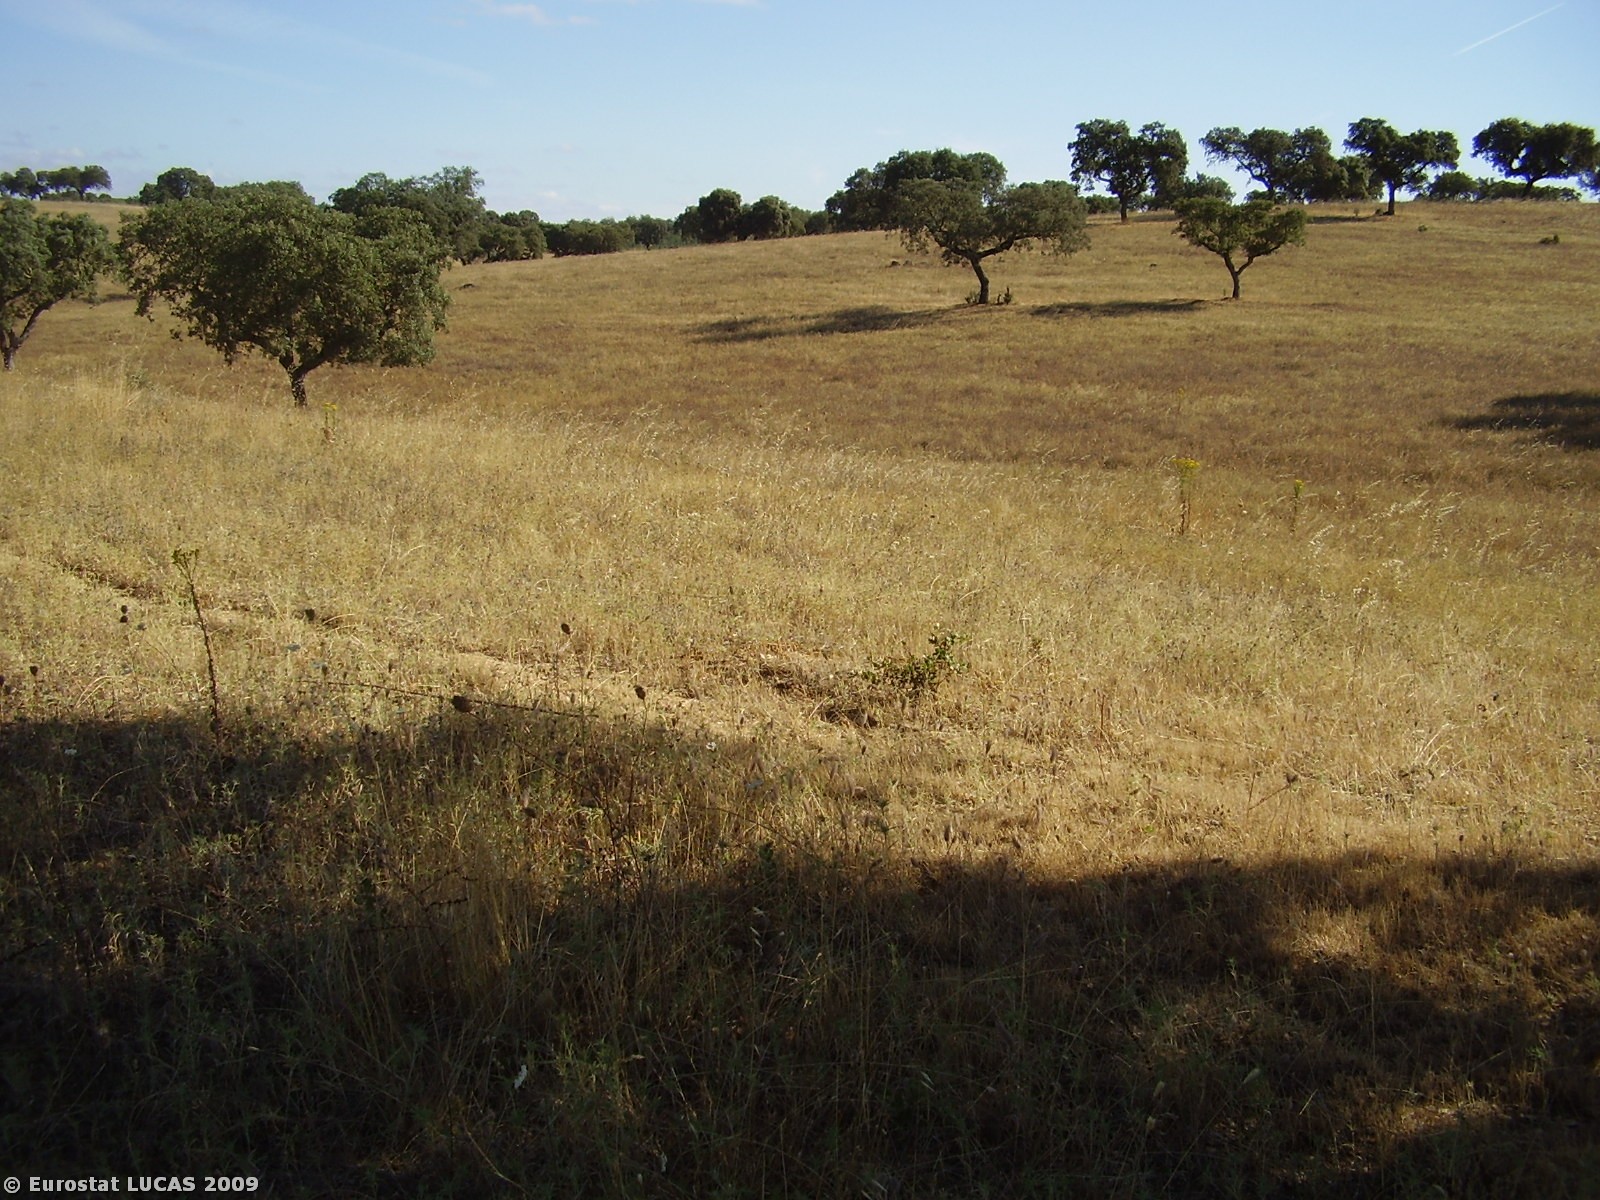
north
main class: Grassland
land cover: Grassland with sparse tree/shrub cover
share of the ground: > 75 %
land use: Fallow land
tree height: > 5 m
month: July
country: PT
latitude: 38.9664
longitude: -7.9484
